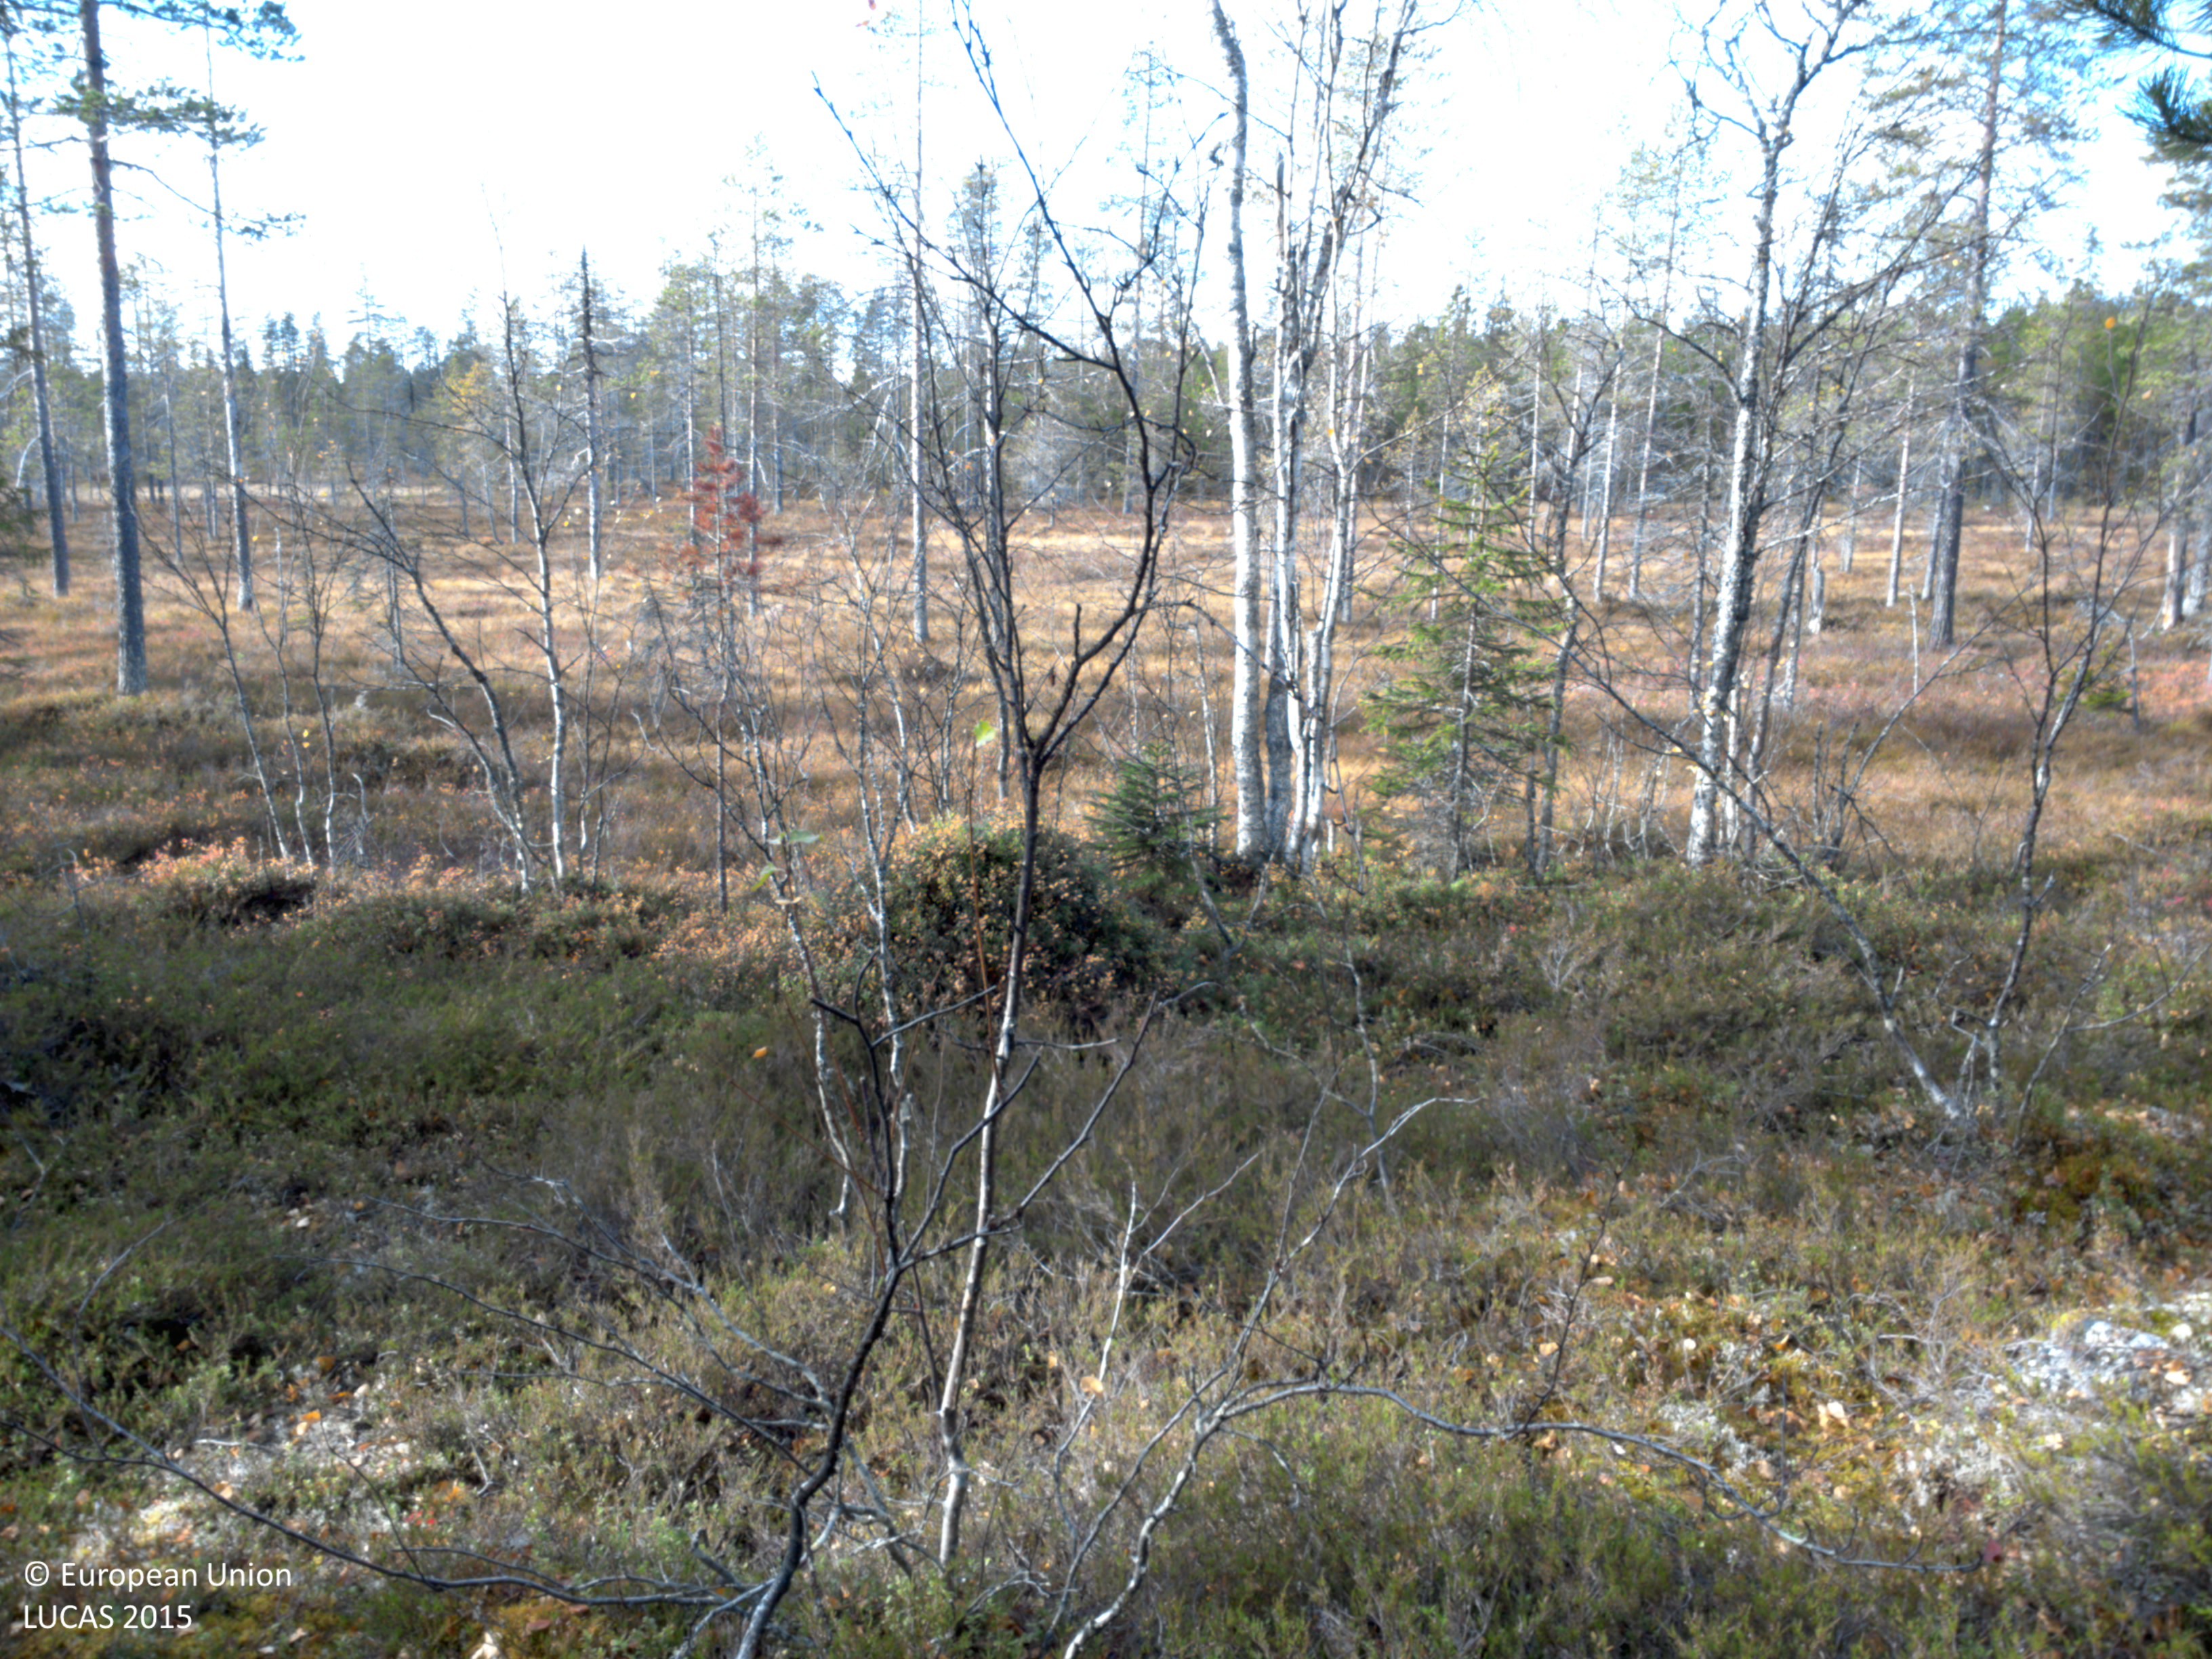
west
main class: Woodland
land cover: Pine dominated coniferous woodland
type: exotic forest
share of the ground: > 75 %
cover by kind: coniferous forest trees 75 %, shrubs 15 %, lichens and mosses 10 %
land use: Forestry
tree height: > 5 m
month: October
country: SE
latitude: 64.8067
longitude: 17.7763
